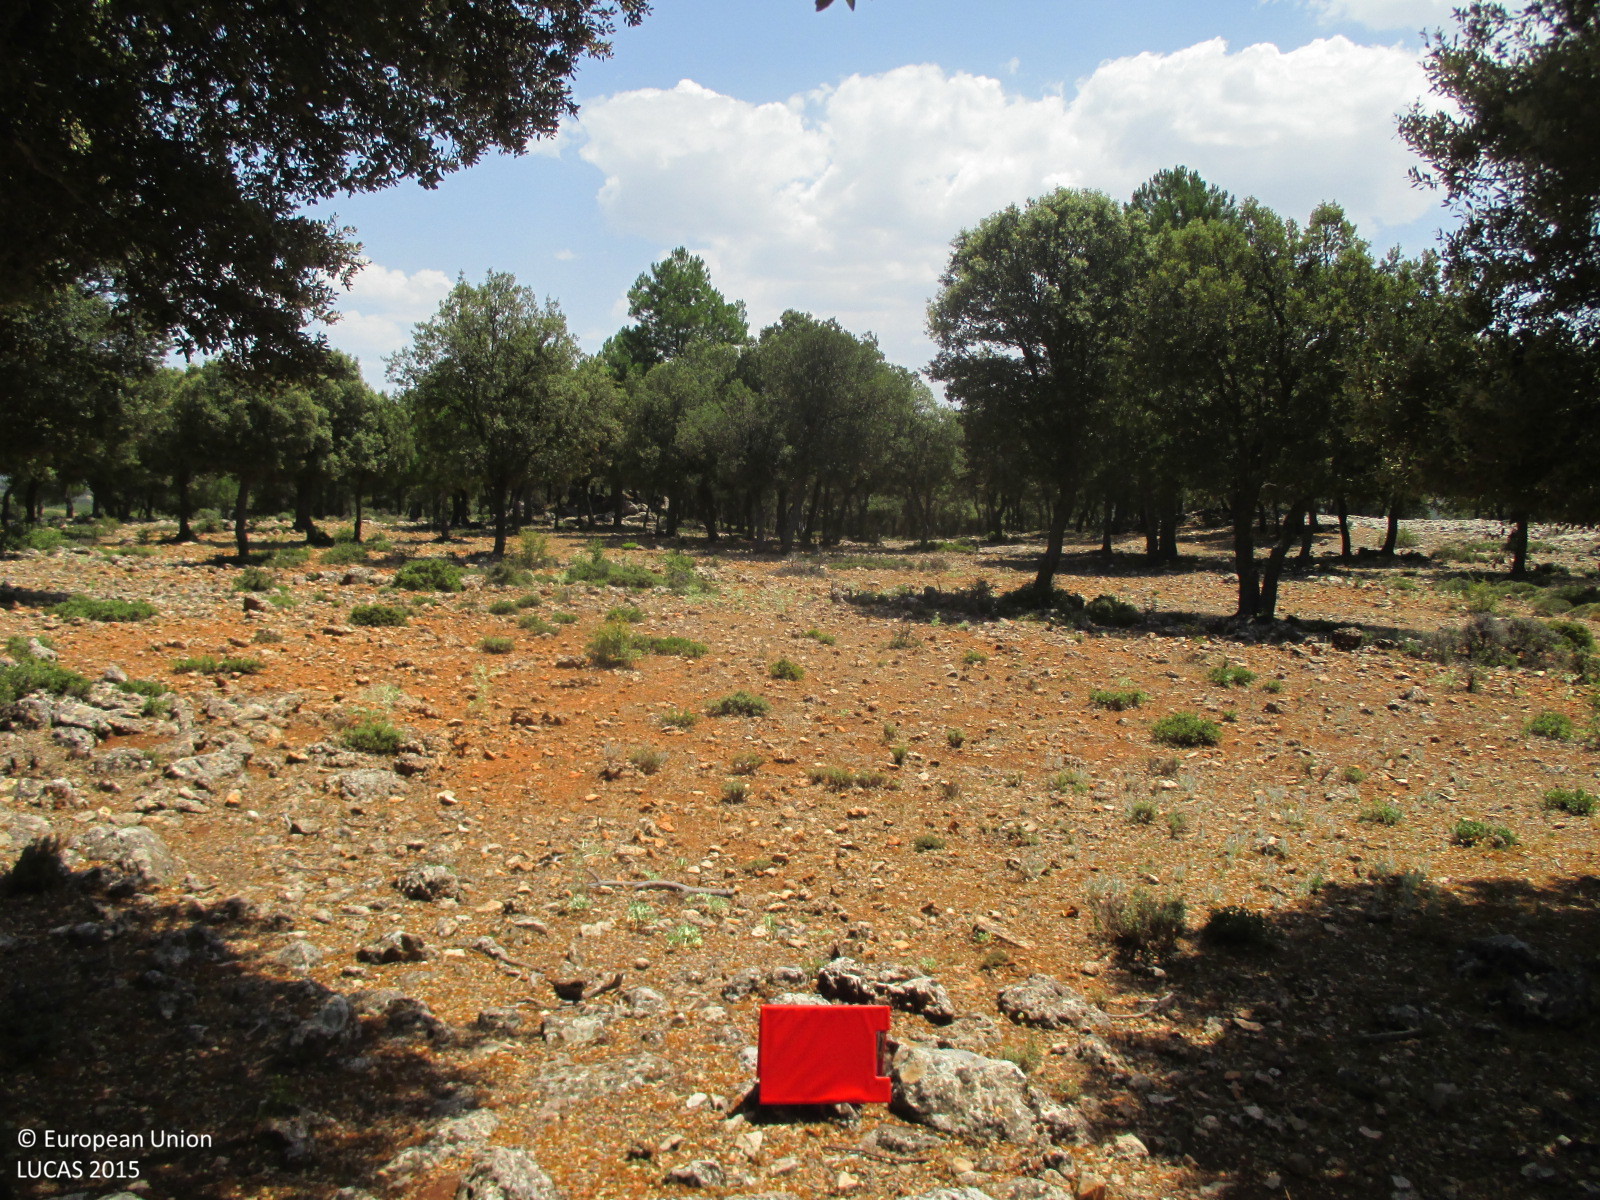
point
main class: Woodland
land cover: Broadleaved woodland
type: broadleaved evergreen forest
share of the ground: > 75 %
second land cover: Grassland without tree/shrub cover
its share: > 75 %
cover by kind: broadleaved forest trees 75 %, herbaceous plants 25 %
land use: Forestry
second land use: Agriculture (excluding fallow land and kitchen gardens)
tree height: > 5 m
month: July
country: ES
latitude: 38.0887
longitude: -2.5242
